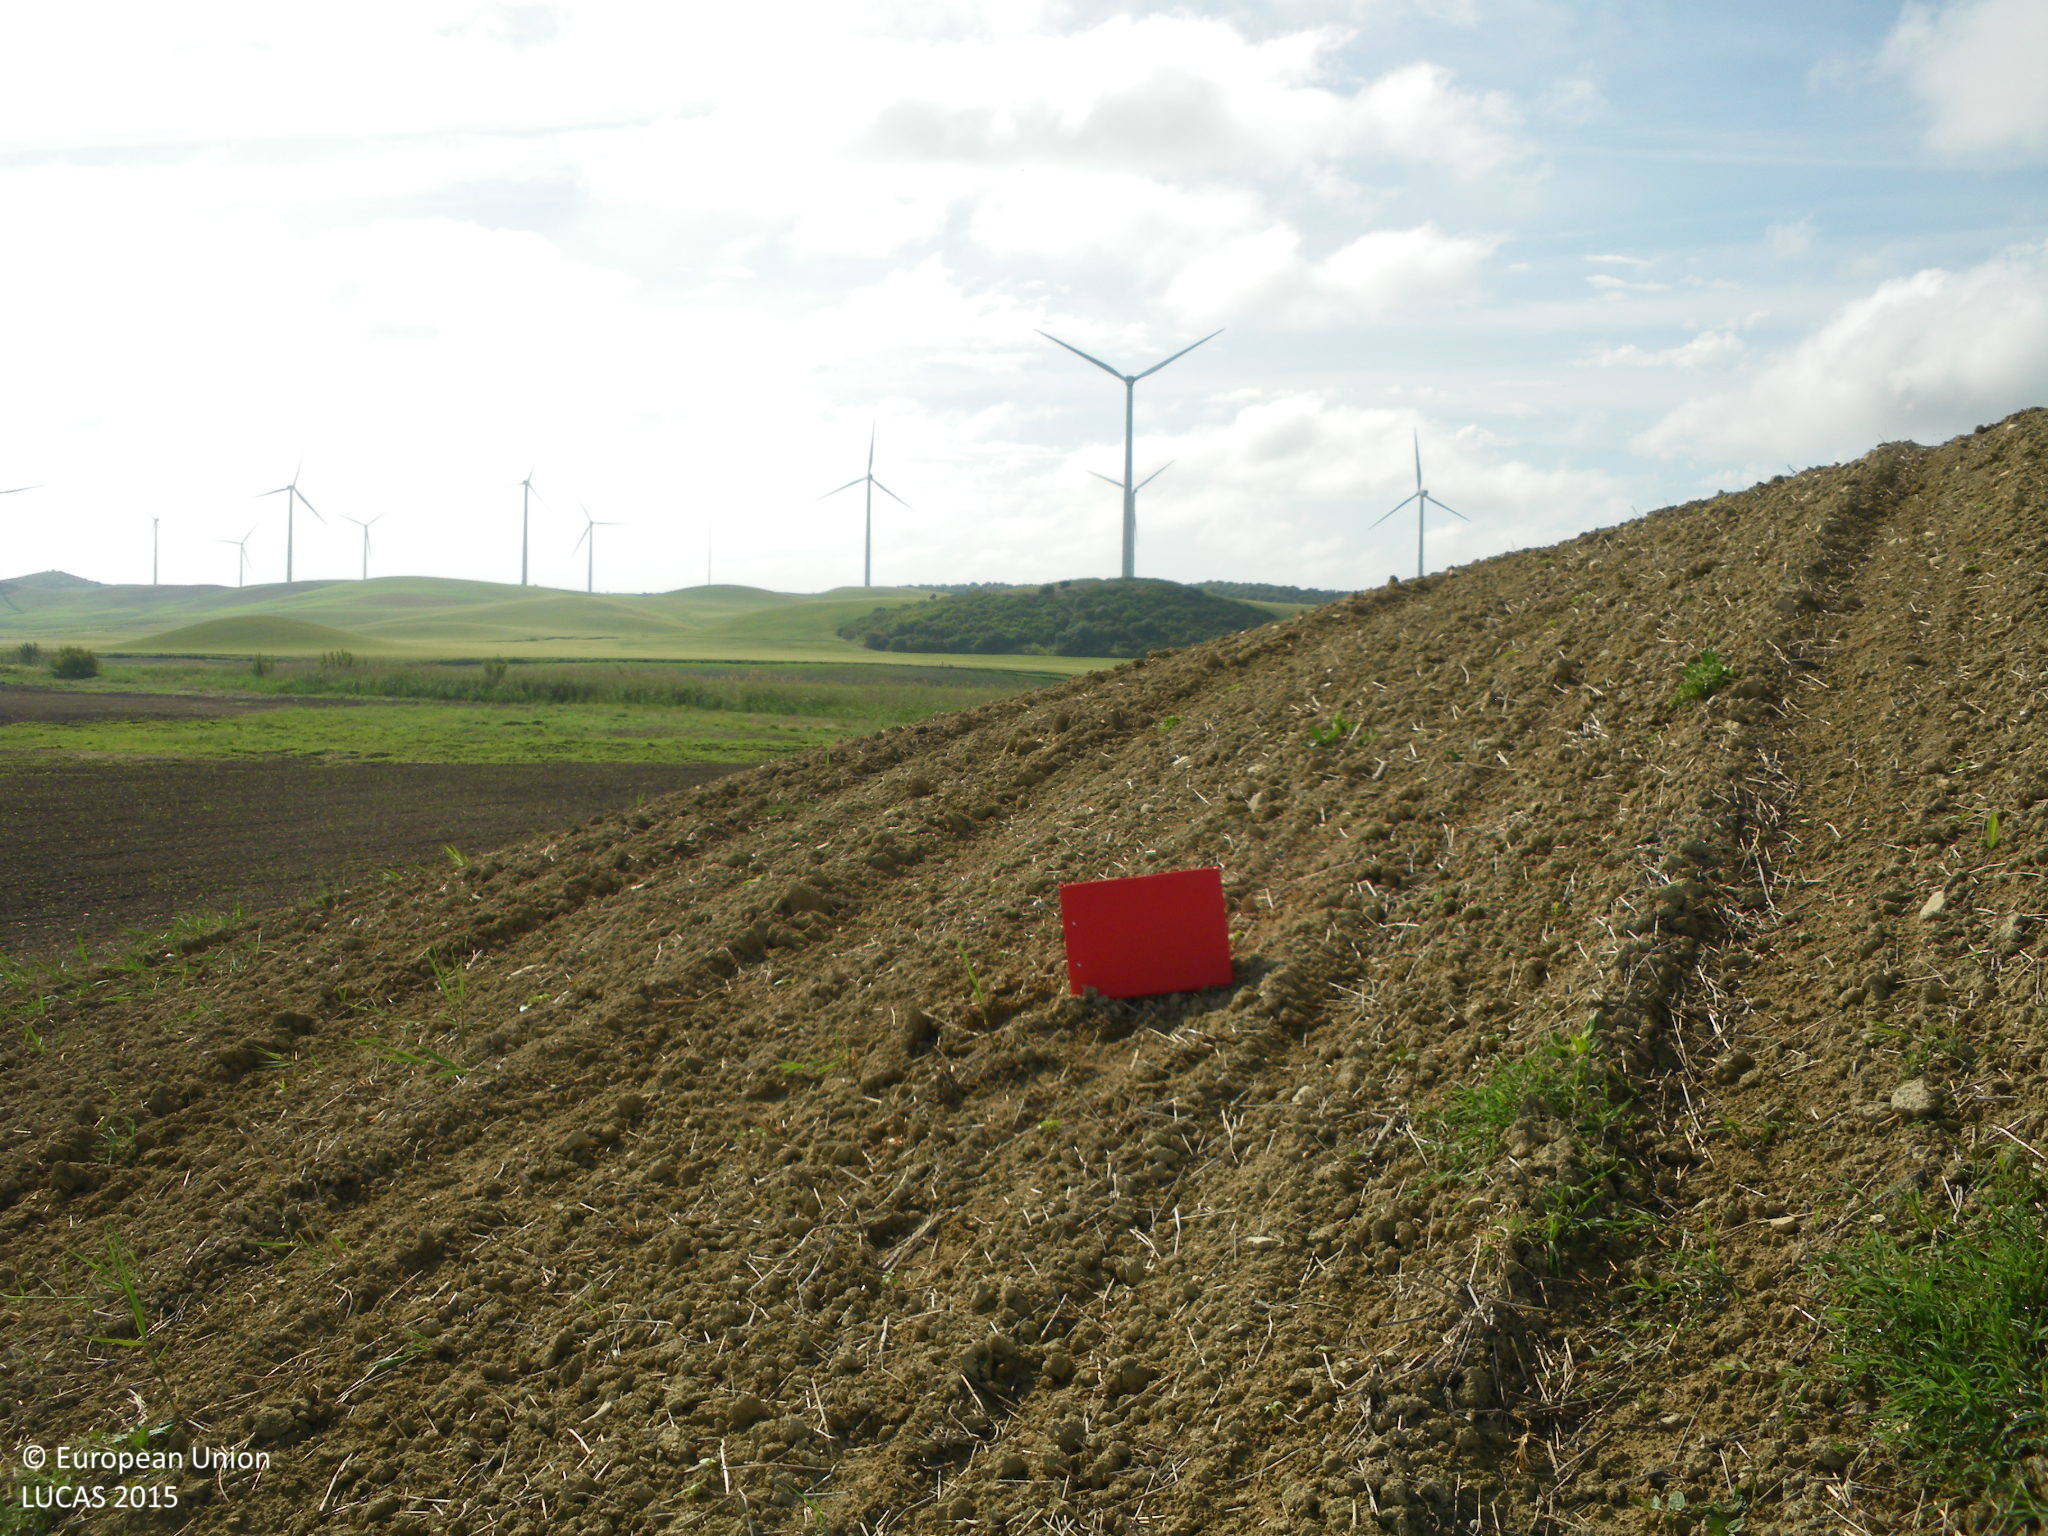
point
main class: Cropland
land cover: Sunflower
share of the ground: < 10 %
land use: Agriculture (excluding fallow land and kitchen gardens)
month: April
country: ES
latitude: 36.5476
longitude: -5.9024
